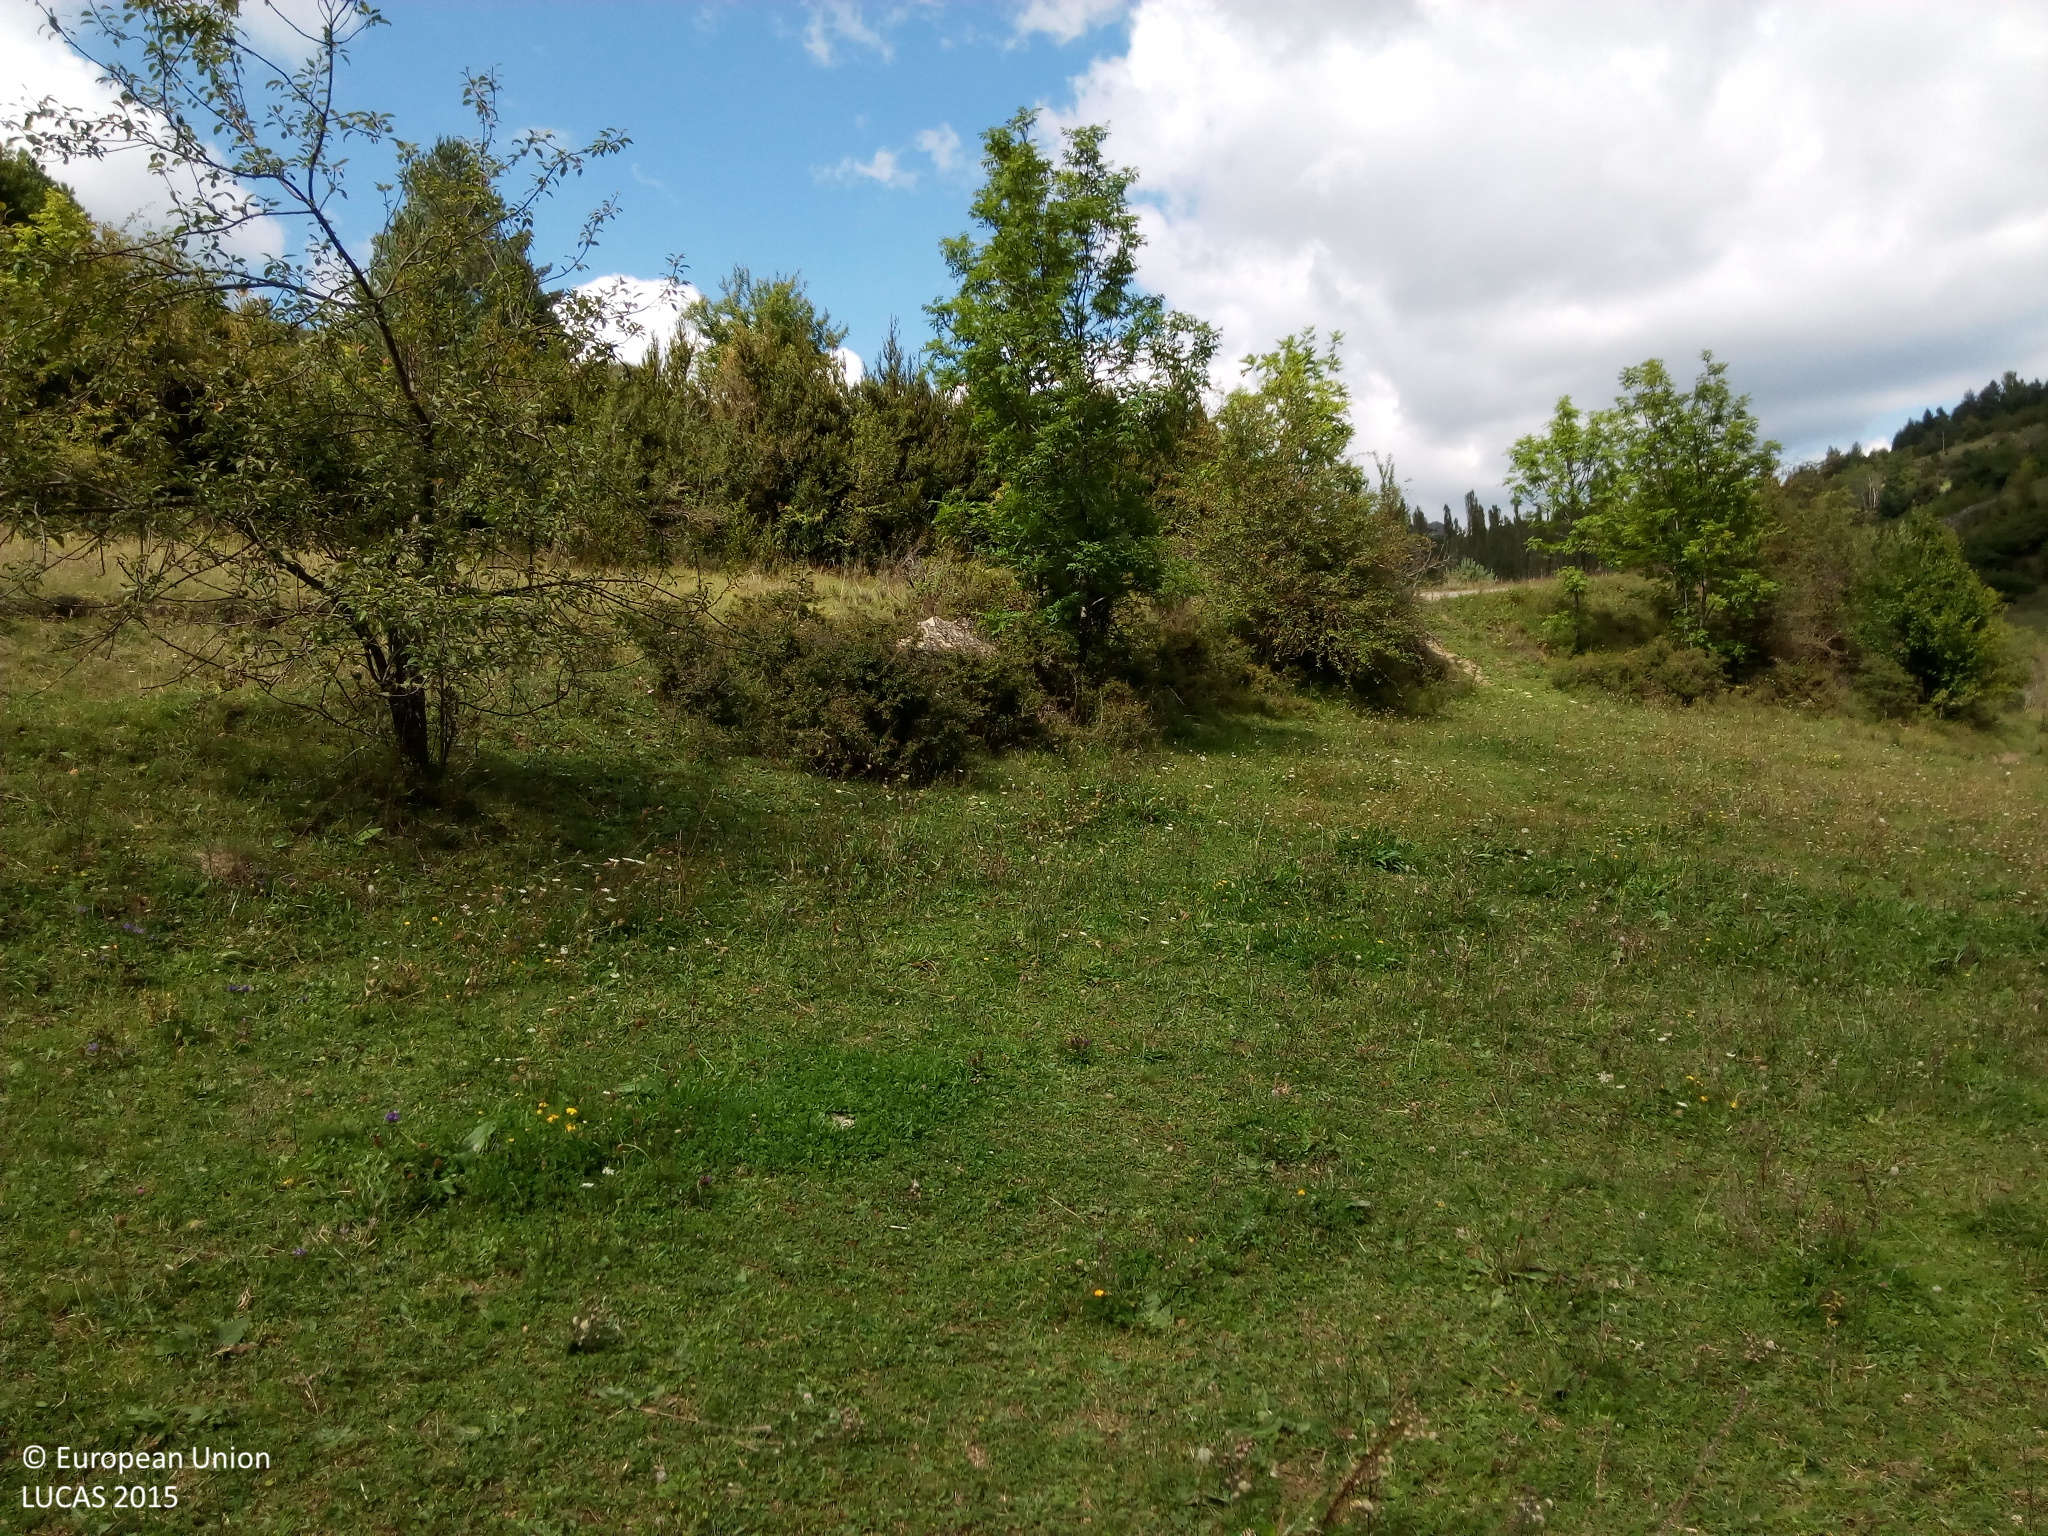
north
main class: Woodland
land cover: Pine dominated coniferous woodland
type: alpine coniferous forest
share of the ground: > 75 %
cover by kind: coniferous forest trees 75 %, shrubs 15 %, herbaceous plants 10 %
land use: Semi-natural and natural areas not in use
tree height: > 5 m
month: September
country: ES
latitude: 42.4304
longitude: 0.5610
